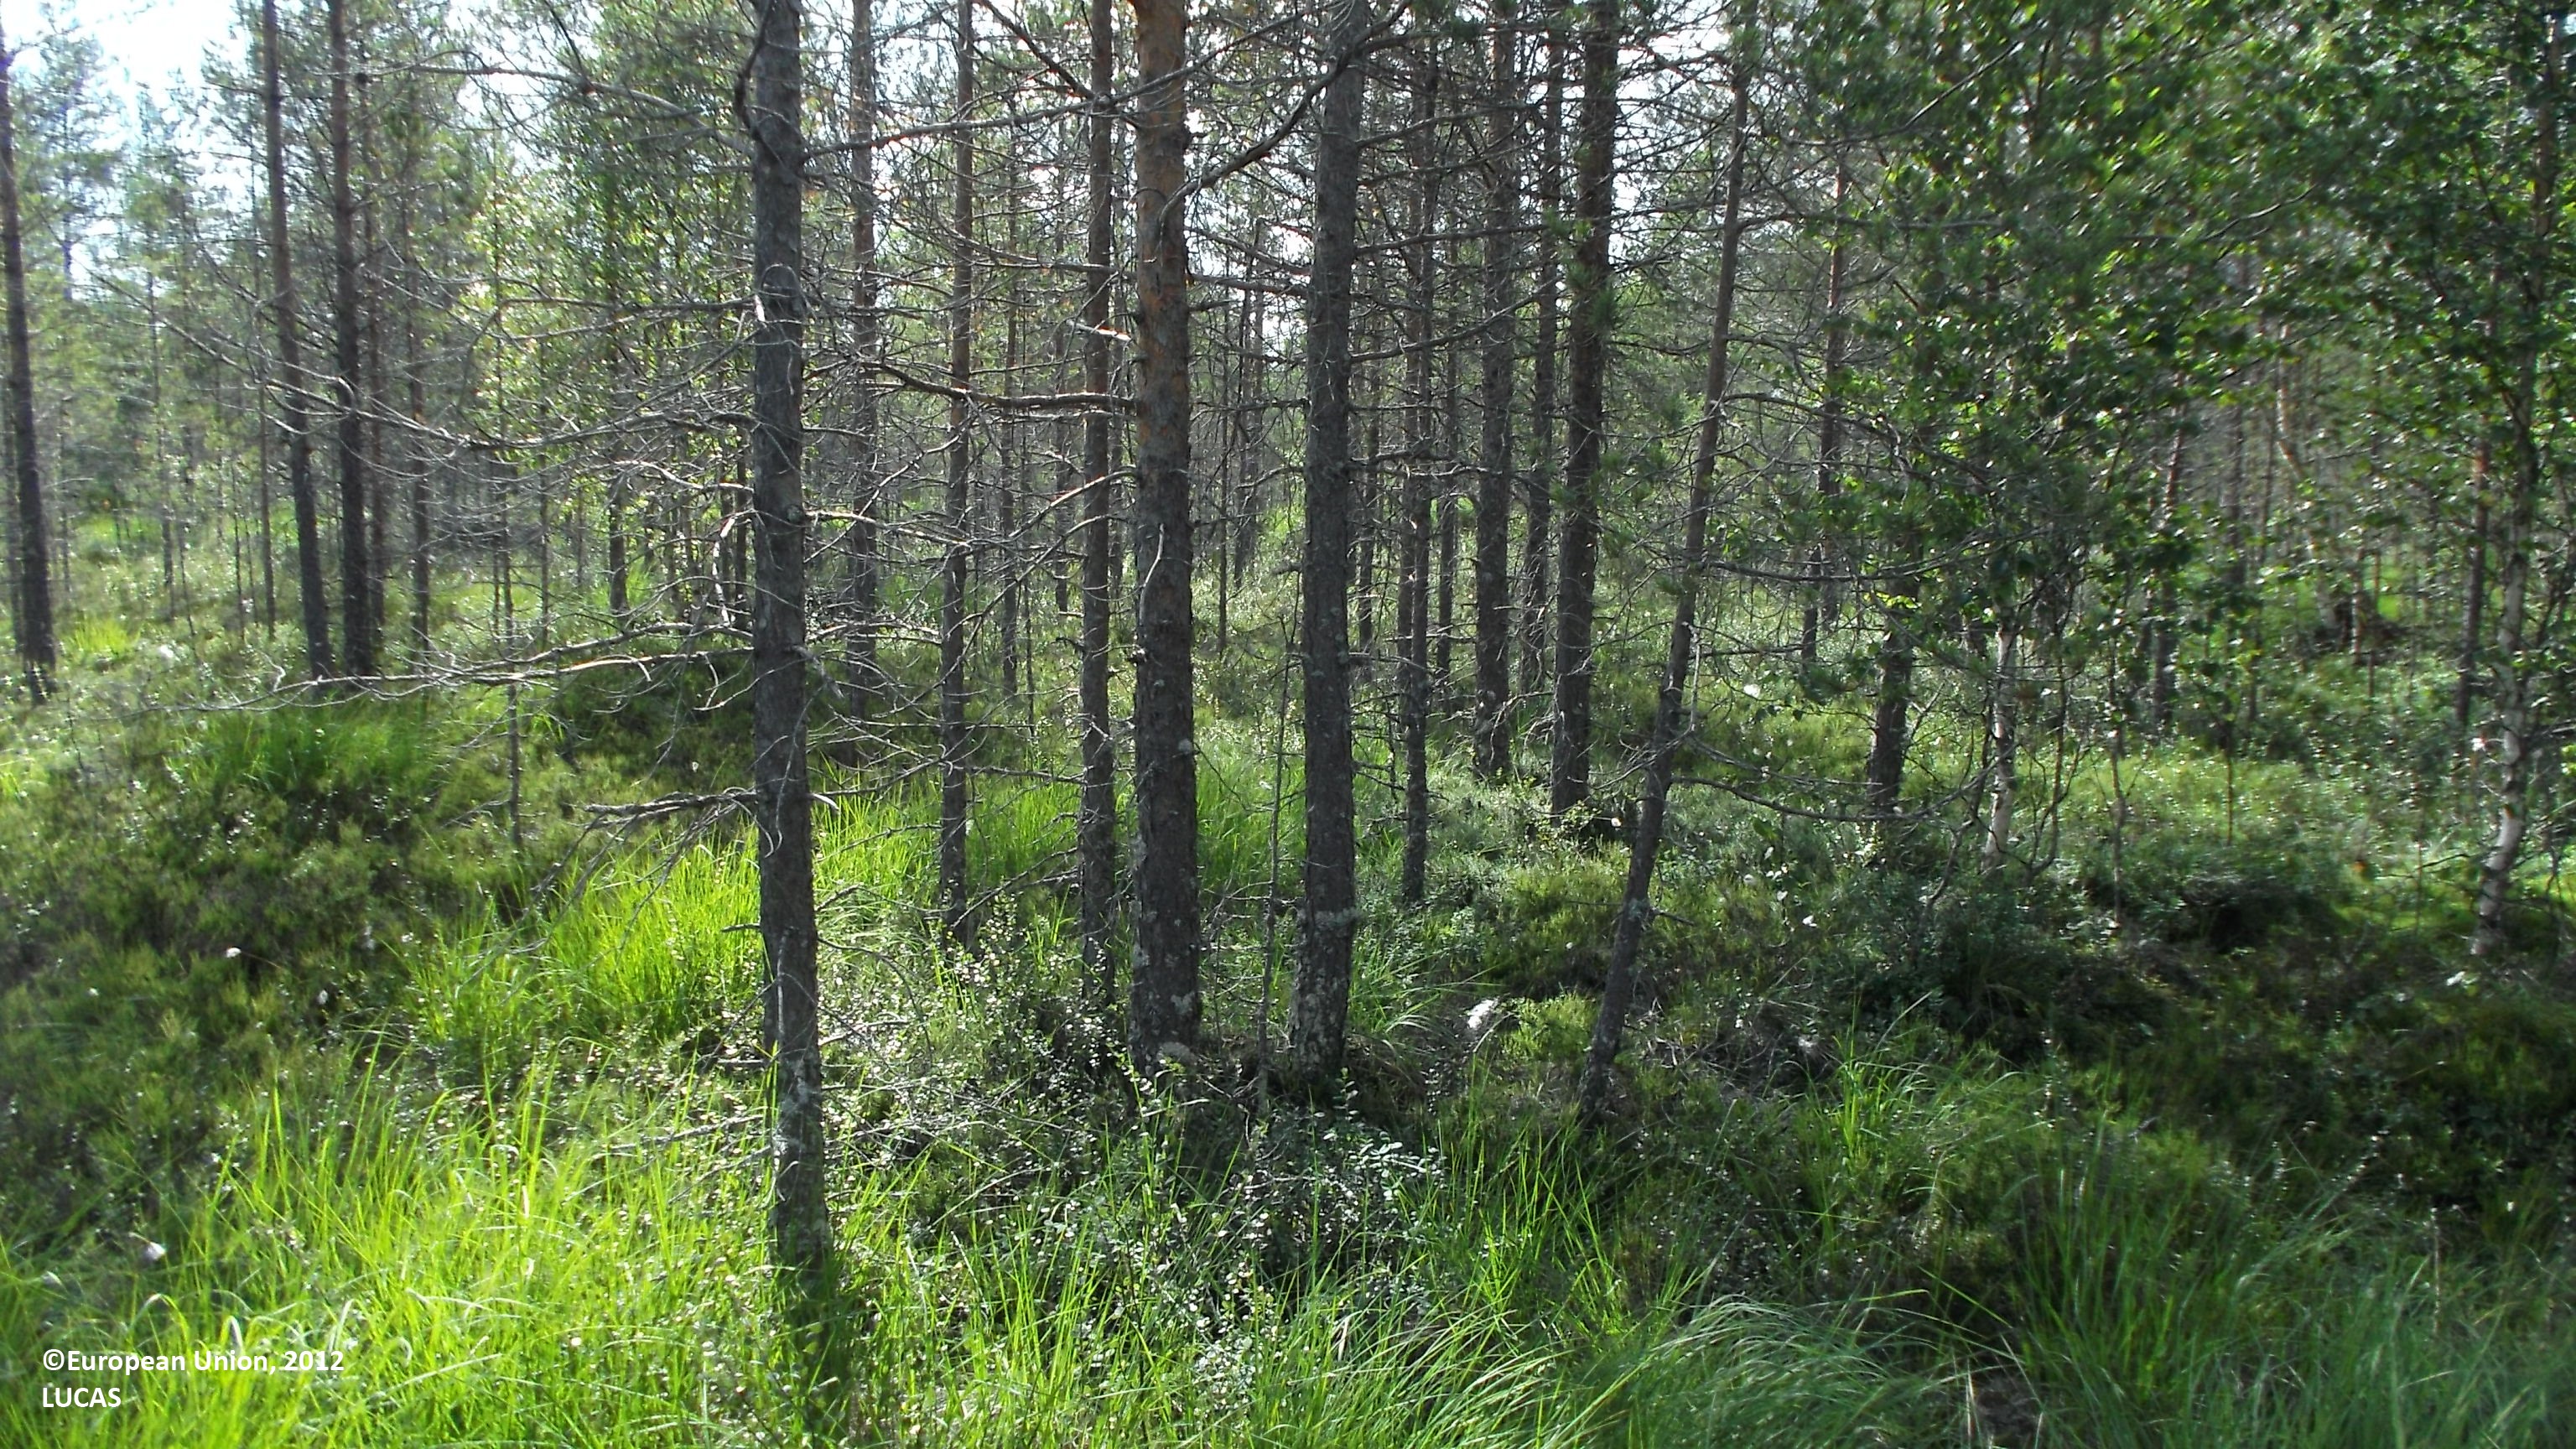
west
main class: Woodland
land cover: Pine dominated mixed woodland
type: mire and swamp forests
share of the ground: 25 - 50 %
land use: Forestry
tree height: > 5 m
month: July
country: FI
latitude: 63.4160
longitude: 24.4813
